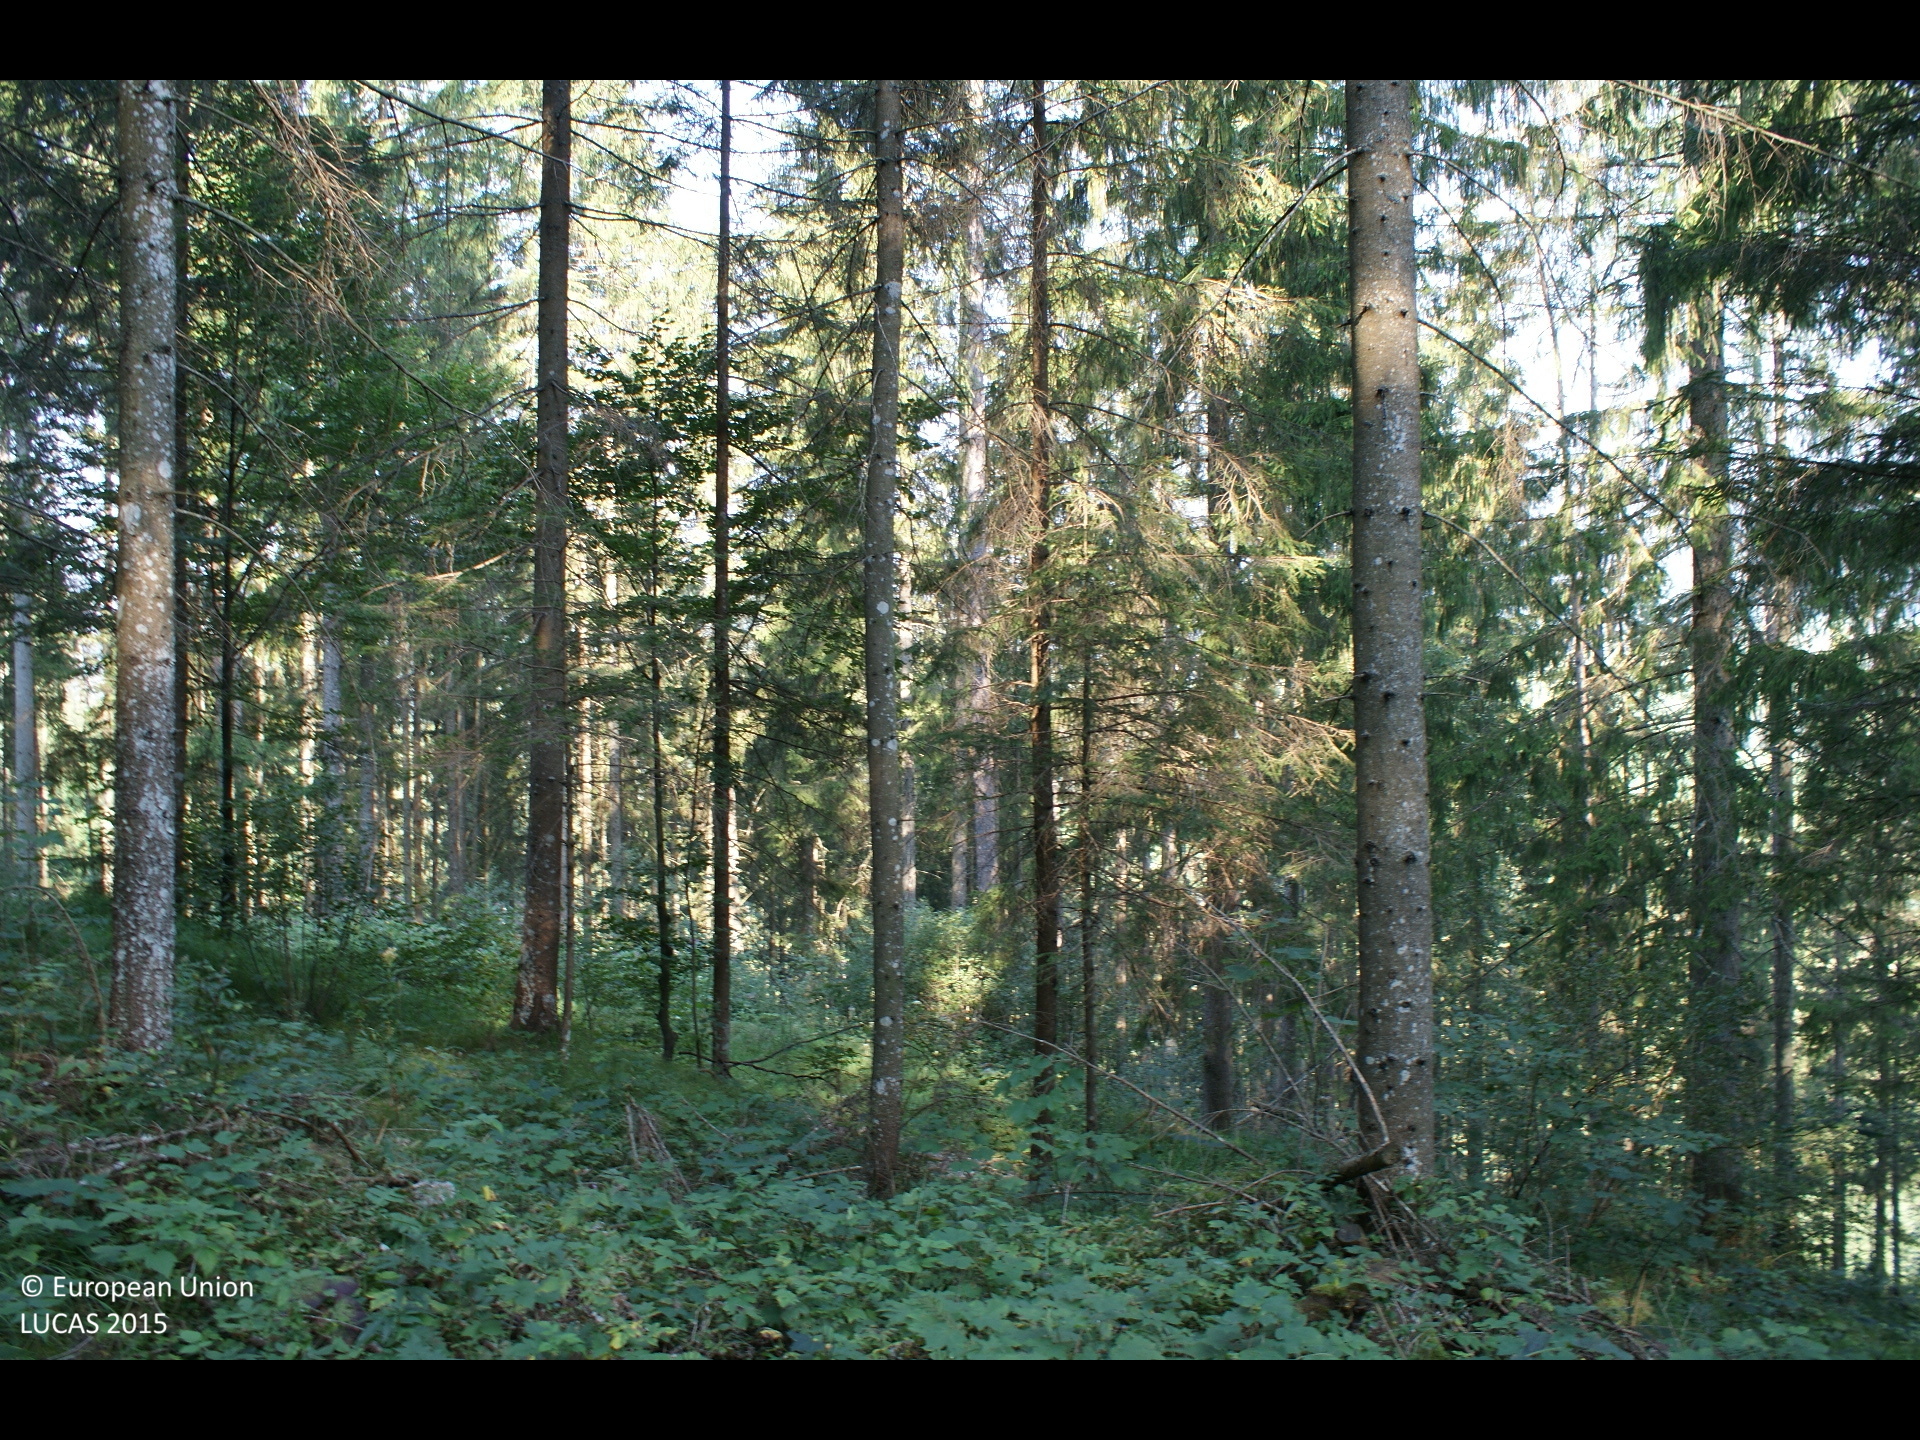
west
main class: Woodland
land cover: Spruce dominated coniferous woodland
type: alpine coniferous forest
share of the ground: 50 - 75 %
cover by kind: coniferous forest trees 50 %, shrubs 30 %, herbaceous plants 20 %
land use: Forestry
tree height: > 5 m
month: August
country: AT
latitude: 47.5369
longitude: 15.3011
